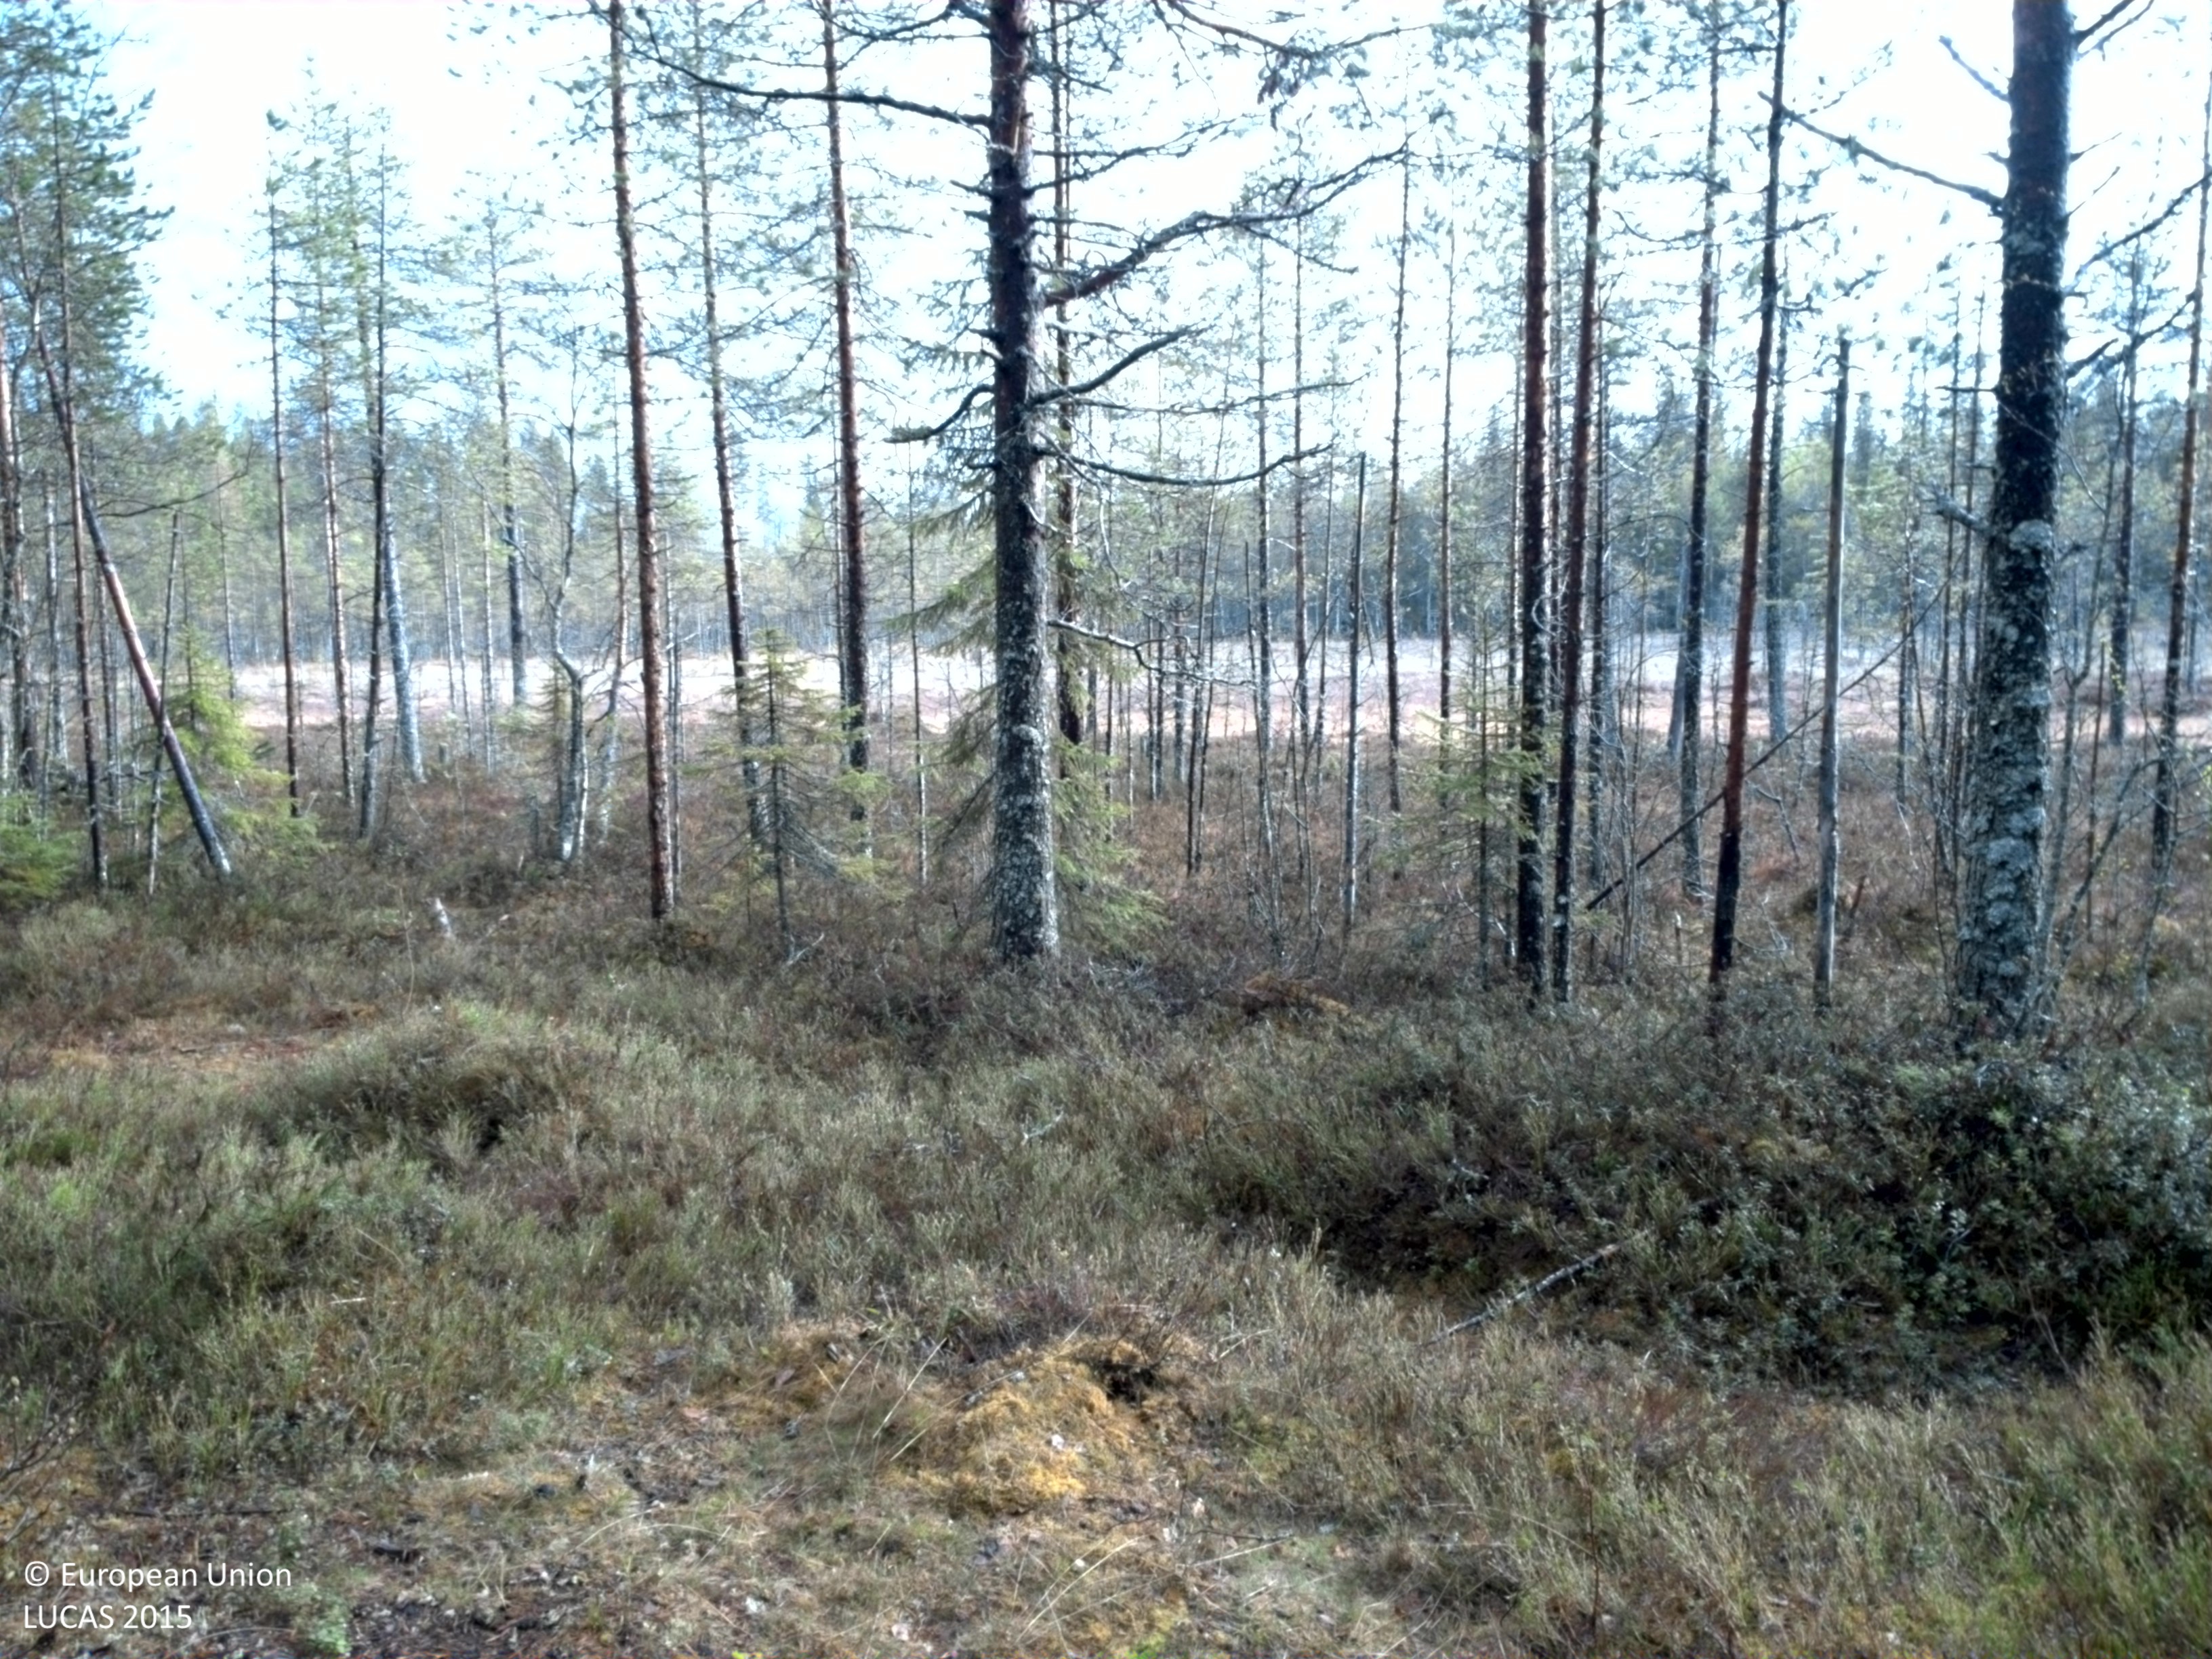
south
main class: Woodland
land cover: Pine dominated coniferous woodland
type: boreal forest
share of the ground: > 75 %
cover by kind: coniferous forest trees 85 %, shrubs 15 %
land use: Forestry
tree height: > 5 m
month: May
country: SE
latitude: 66.2927
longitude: 23.1550
